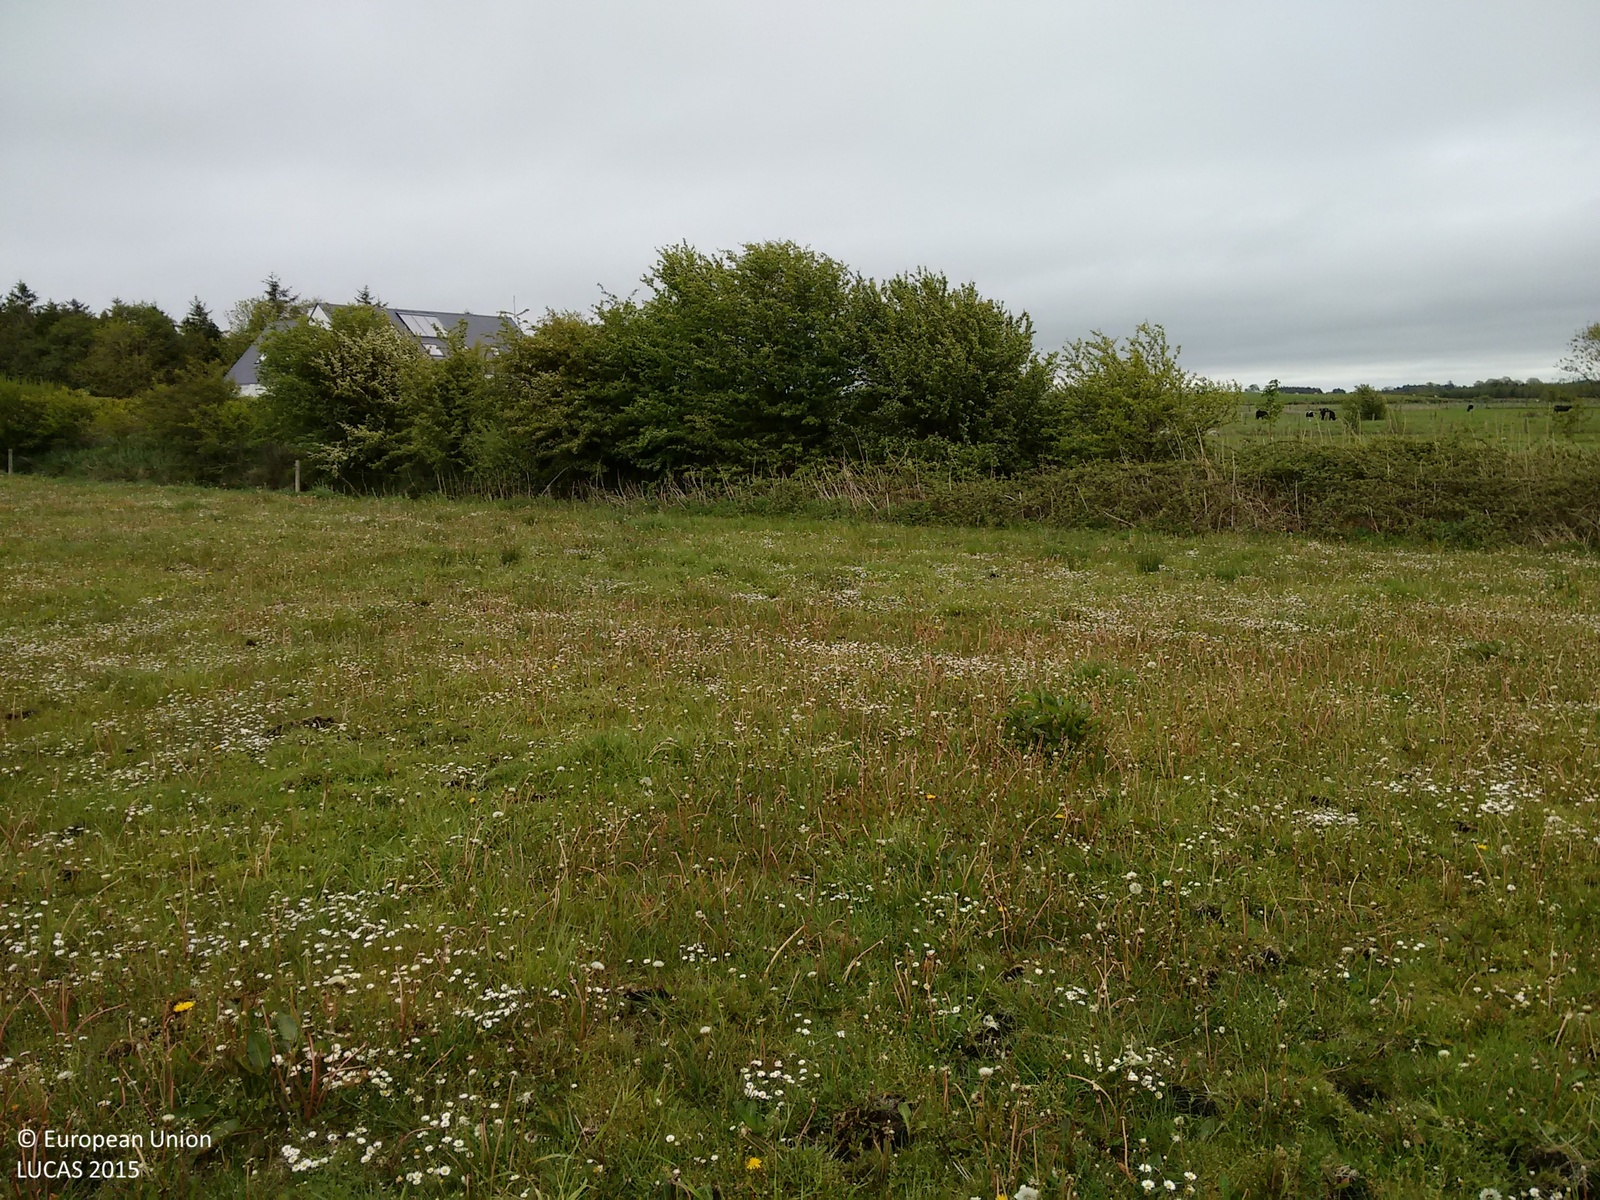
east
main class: Grassland
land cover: Grassland without tree/shrub cover
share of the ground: > 75 %
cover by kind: herbaceous plants 100 %
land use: Agriculture (excluding fallow land and kitchen gardens)
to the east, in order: Grassland without tree/shrub cover; Ditches and canals; Fences; Broadleaved woodland; Grass margins; Paved roads, cycling and walking lanes; Grass margins; Rocks and stones; Artificial constructions in urban areas; Ditches and canals; Spruce dominated coniferous woodland; Grassland without tree/shrub cover; Paved roads, cycling and walking lanes; Grassland without tree/shrub cover
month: May
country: IE
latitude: 53.2939
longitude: -8.6994
